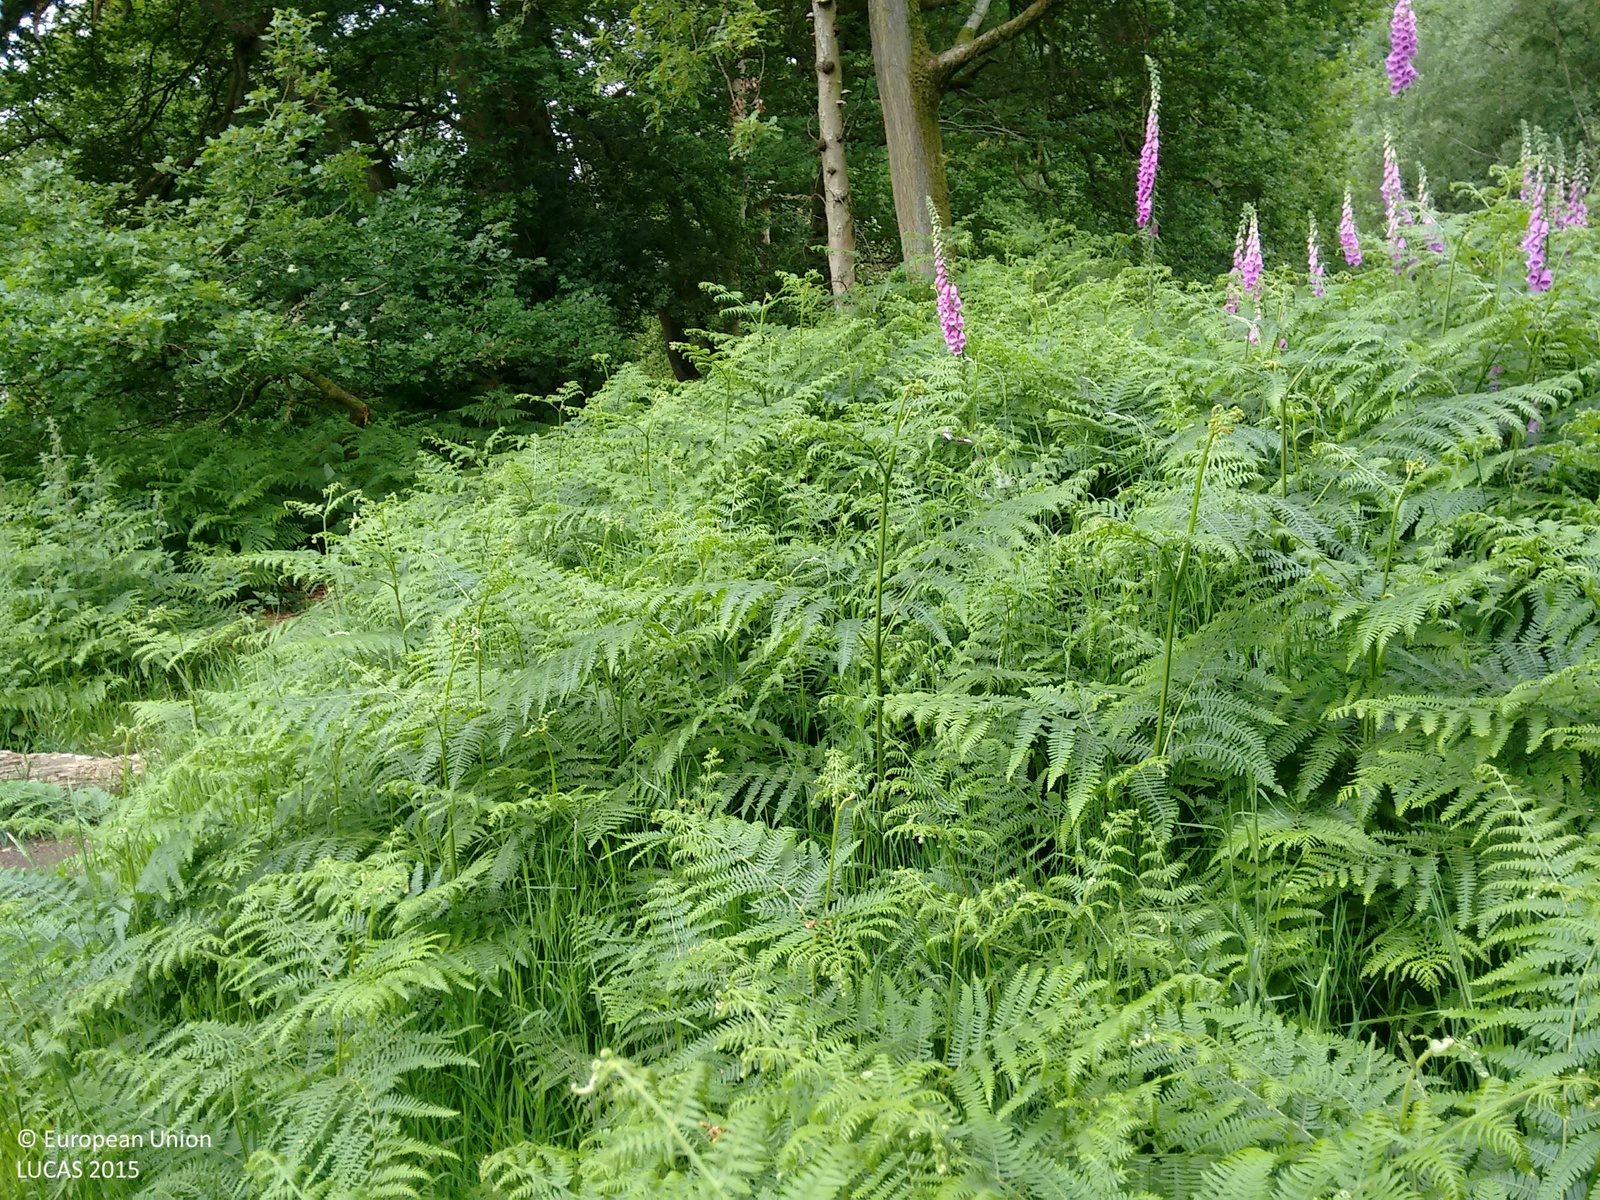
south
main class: Woodland
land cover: Broadleaved woodland
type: mesophytic deciduous forest
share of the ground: > 75 %
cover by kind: broadleaved forest trees 95 %, shrubs 5 %
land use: Semi-natural and natural areas not in use
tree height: > 5 m
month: June
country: GB
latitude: 52.3433
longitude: -2.7380
